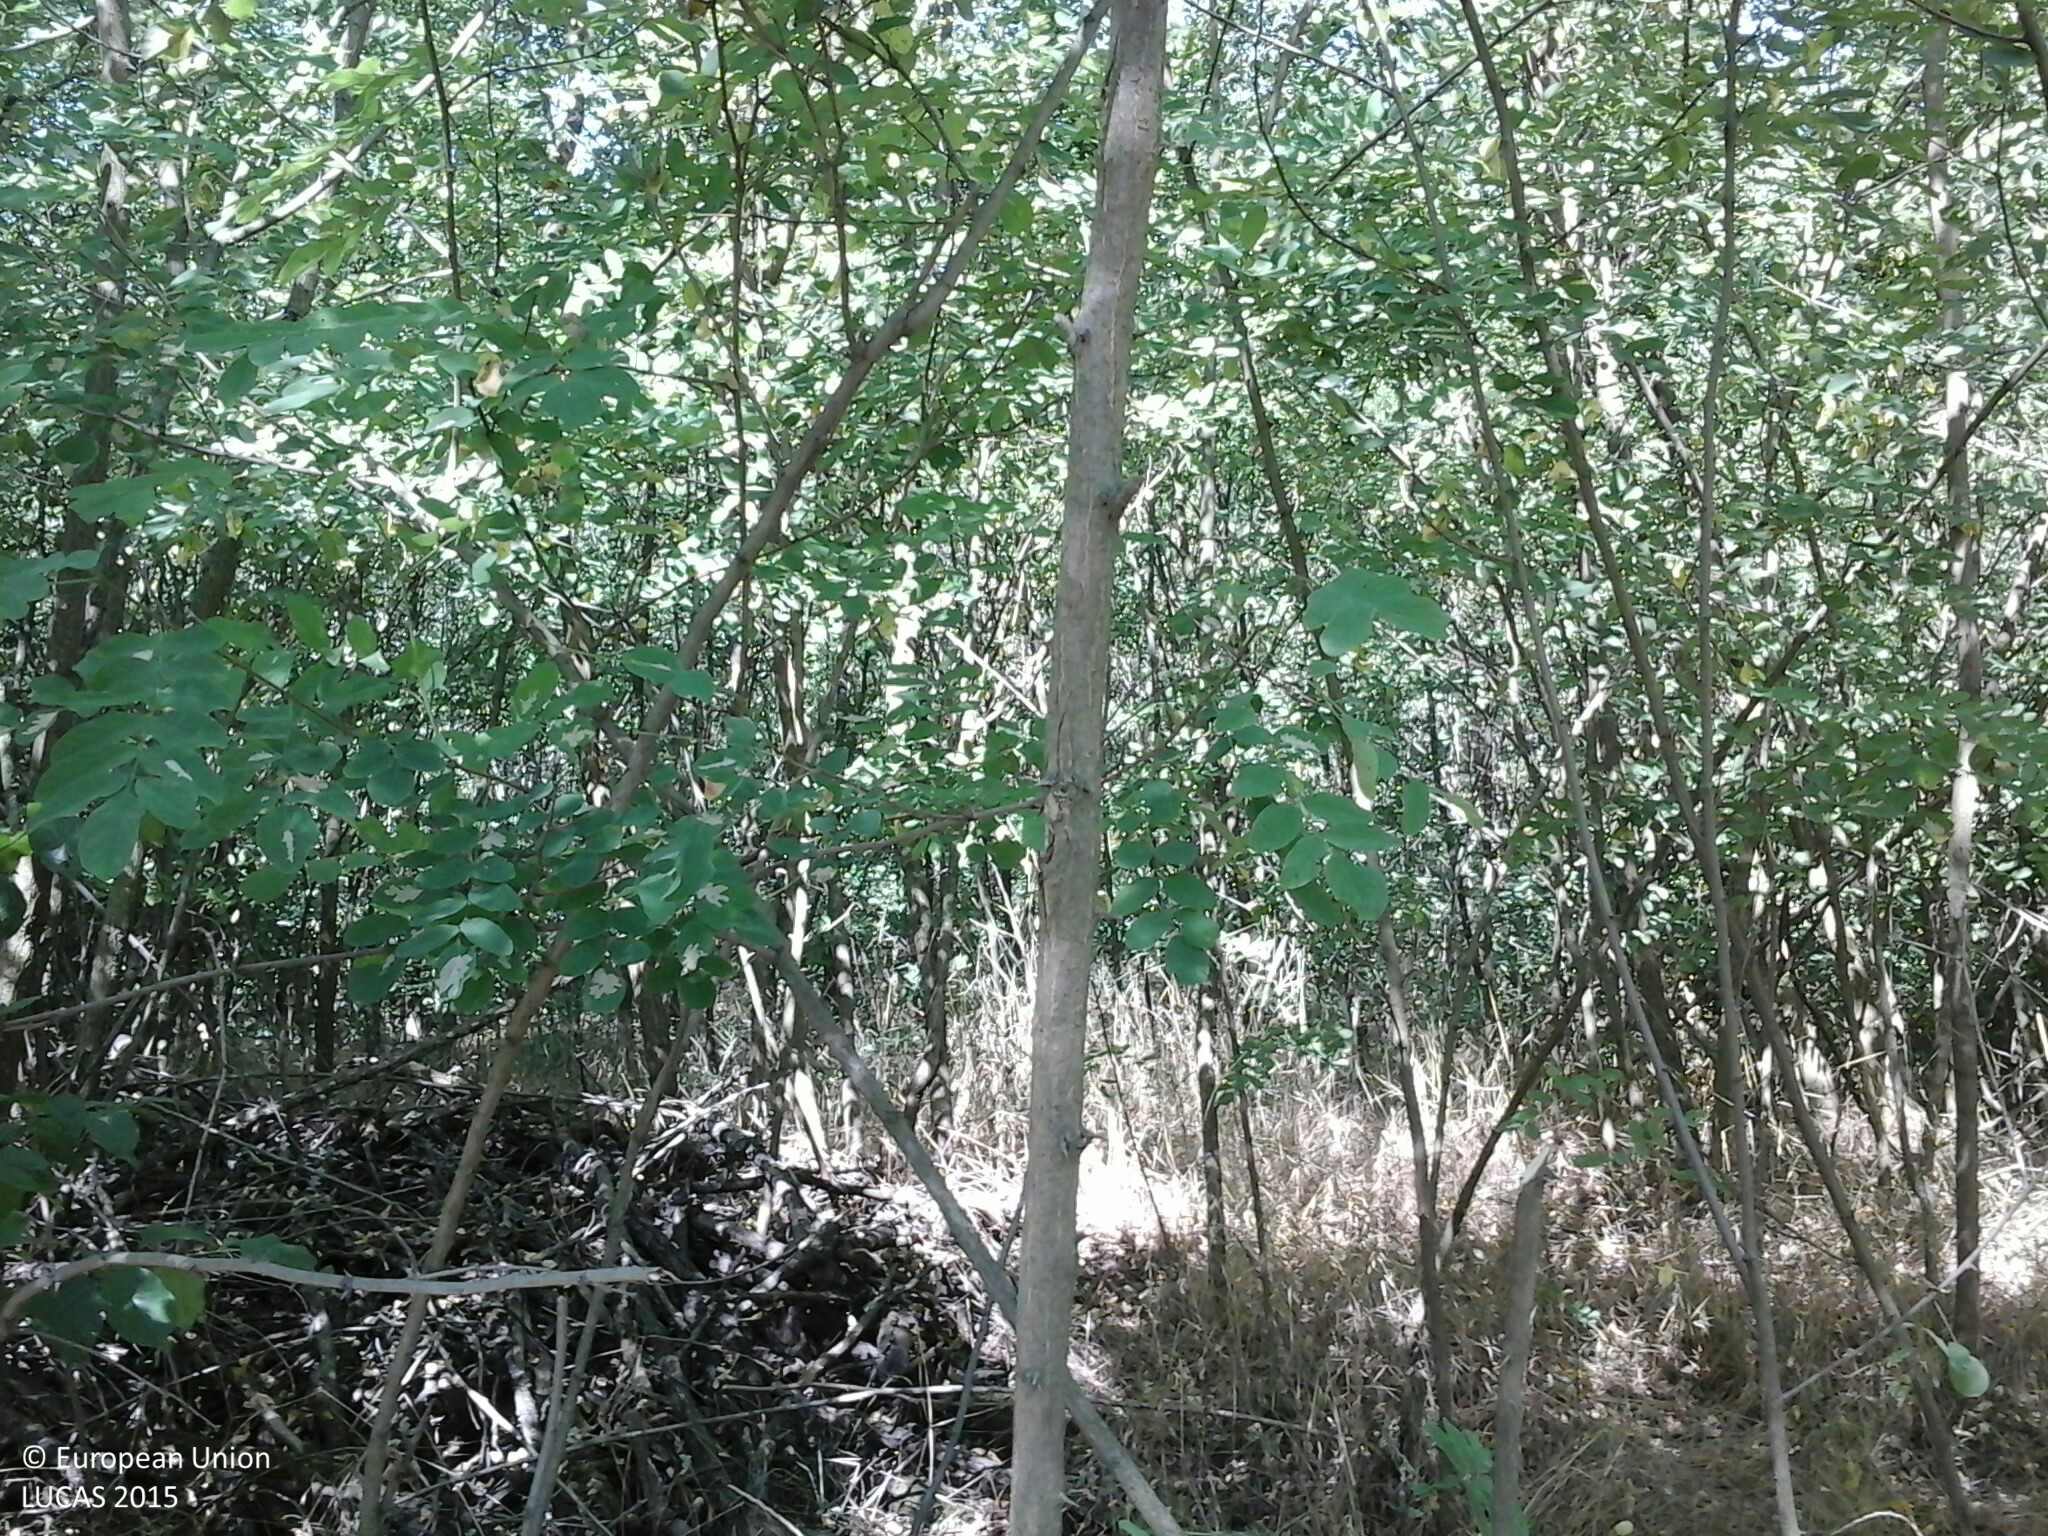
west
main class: Woodland
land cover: Broadleaved woodland
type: exotic forest
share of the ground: > 75 %
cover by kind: broadleaved forest trees 95 %, herbaceous plants 5 %
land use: Forestry
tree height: > 5 m
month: July
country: HU
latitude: 47.6365
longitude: 22.1779
